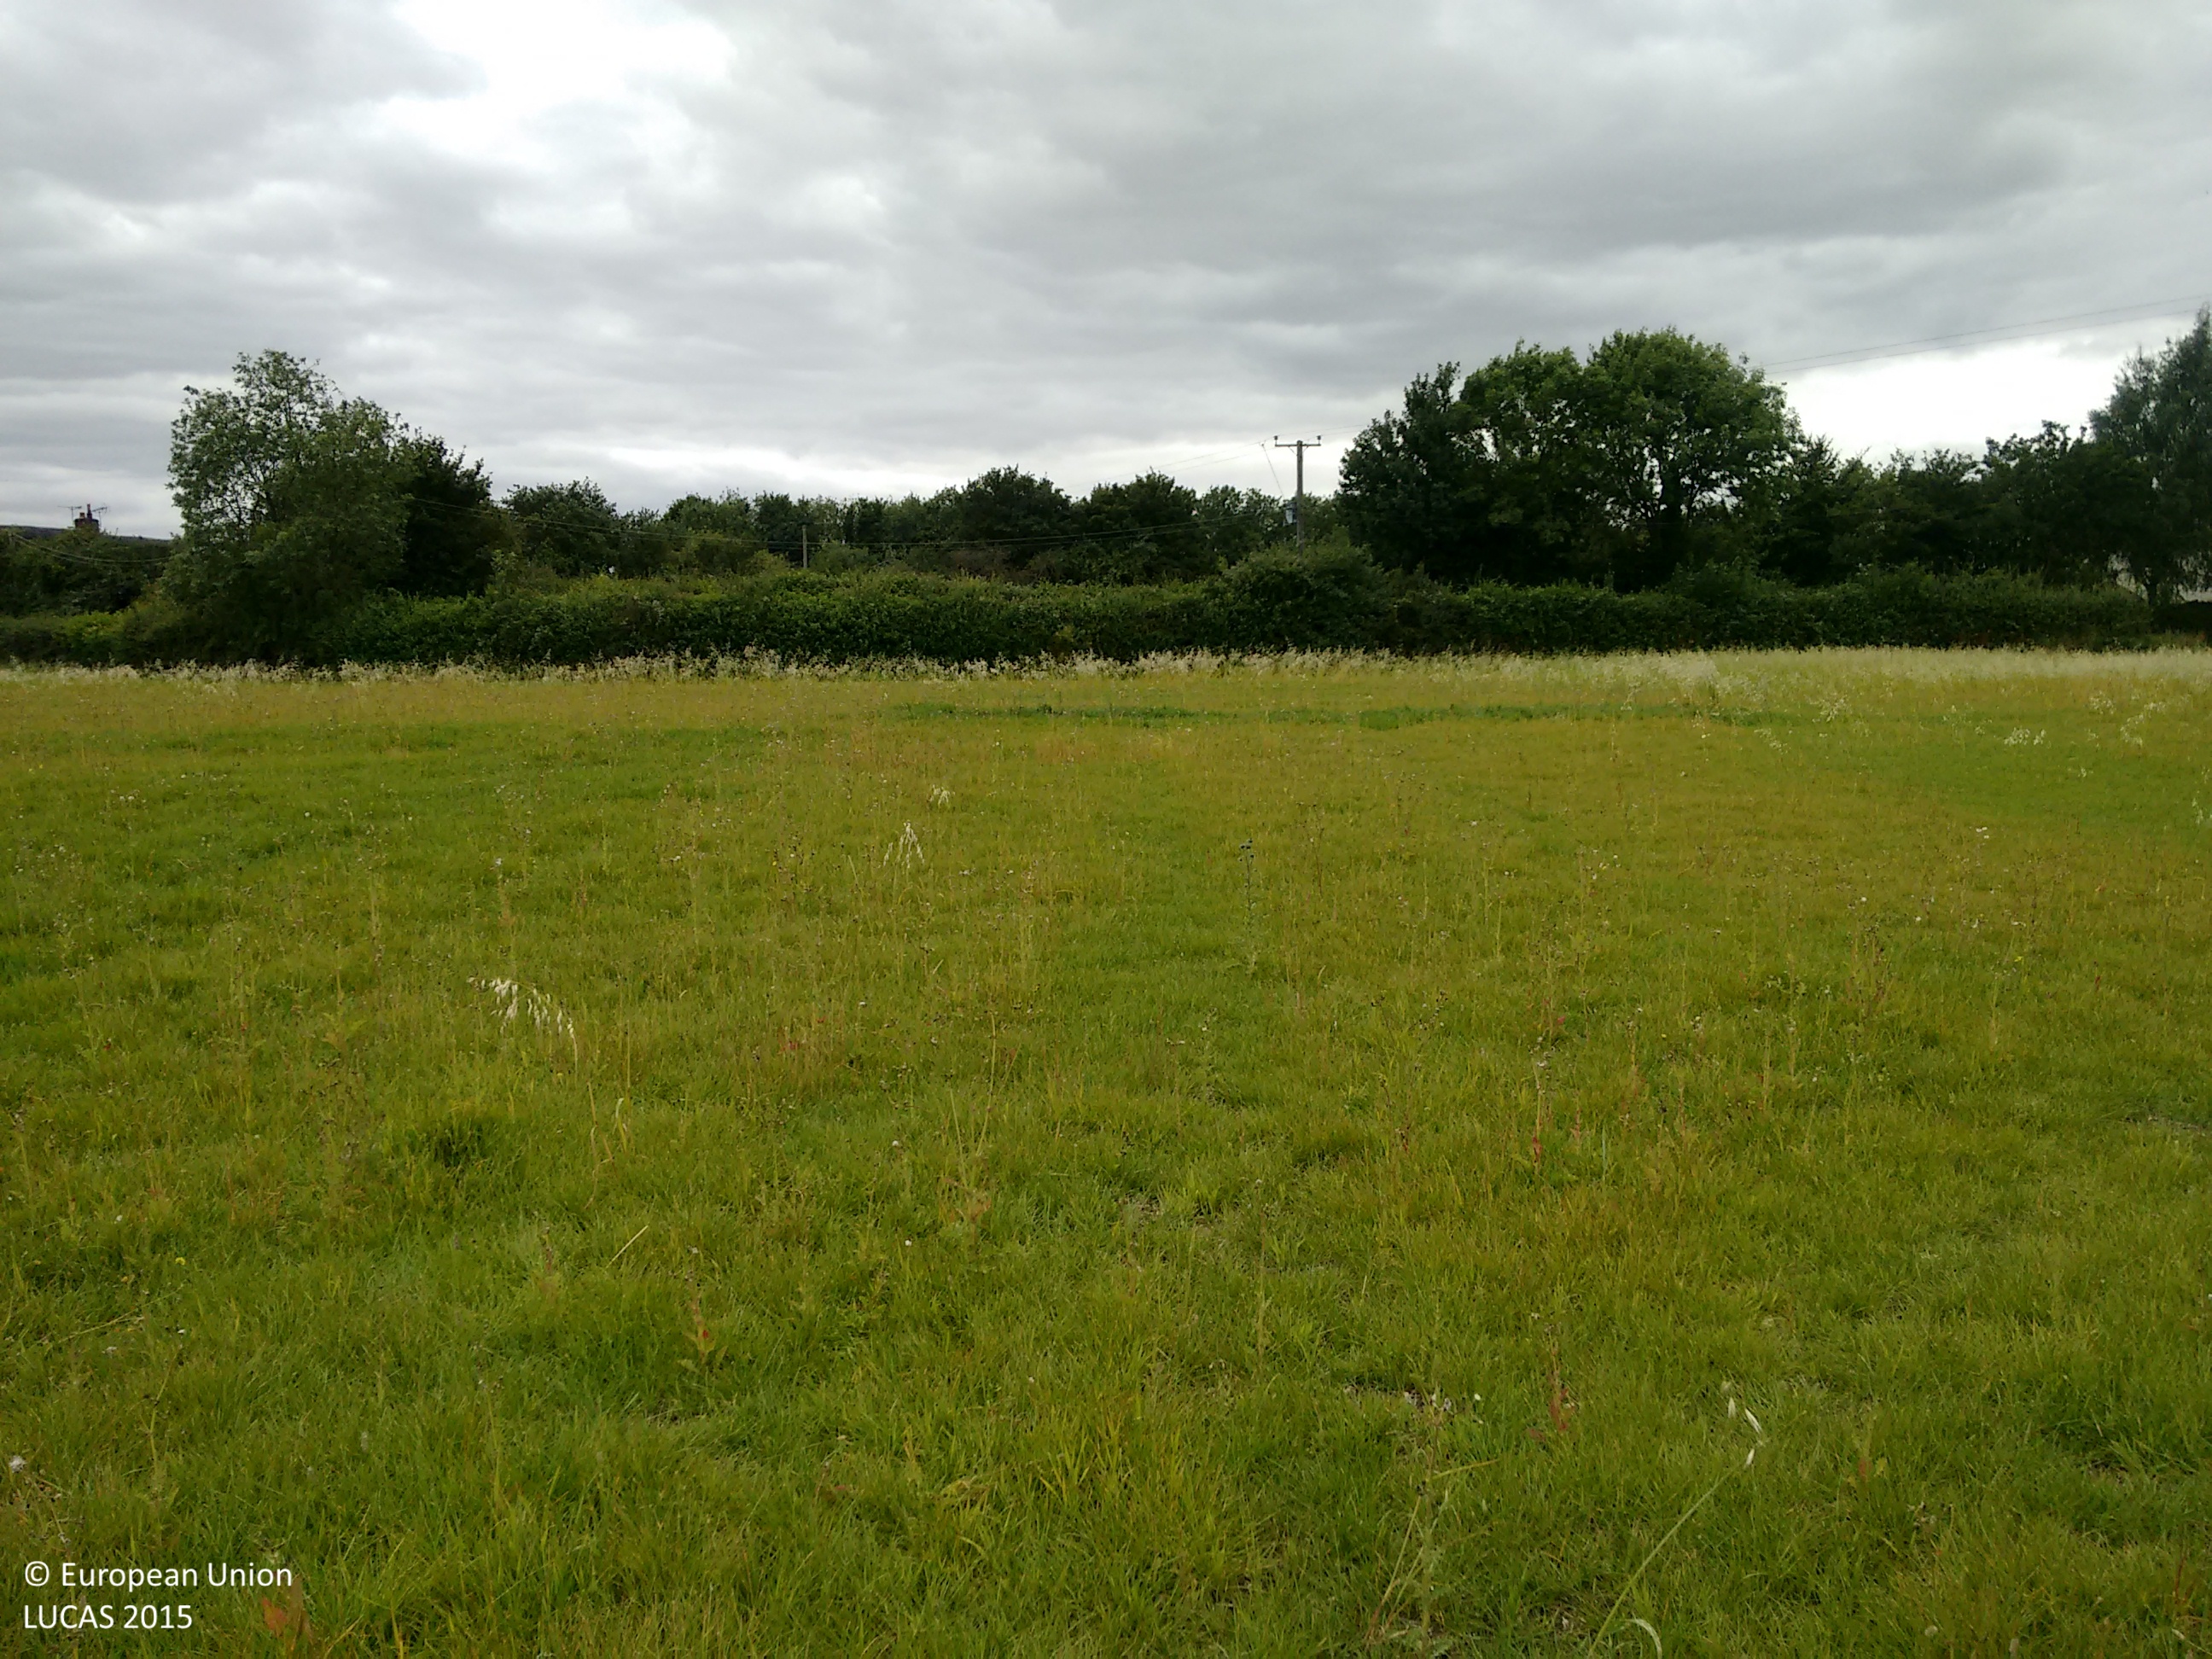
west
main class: Grassland
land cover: Grassland without tree/shrub cover
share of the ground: > 75 %
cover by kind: herbaceous plants 100 %
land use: Agriculture (excluding fallow land and kitchen gardens)
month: August
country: GB
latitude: 52.0057
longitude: 0.4003
